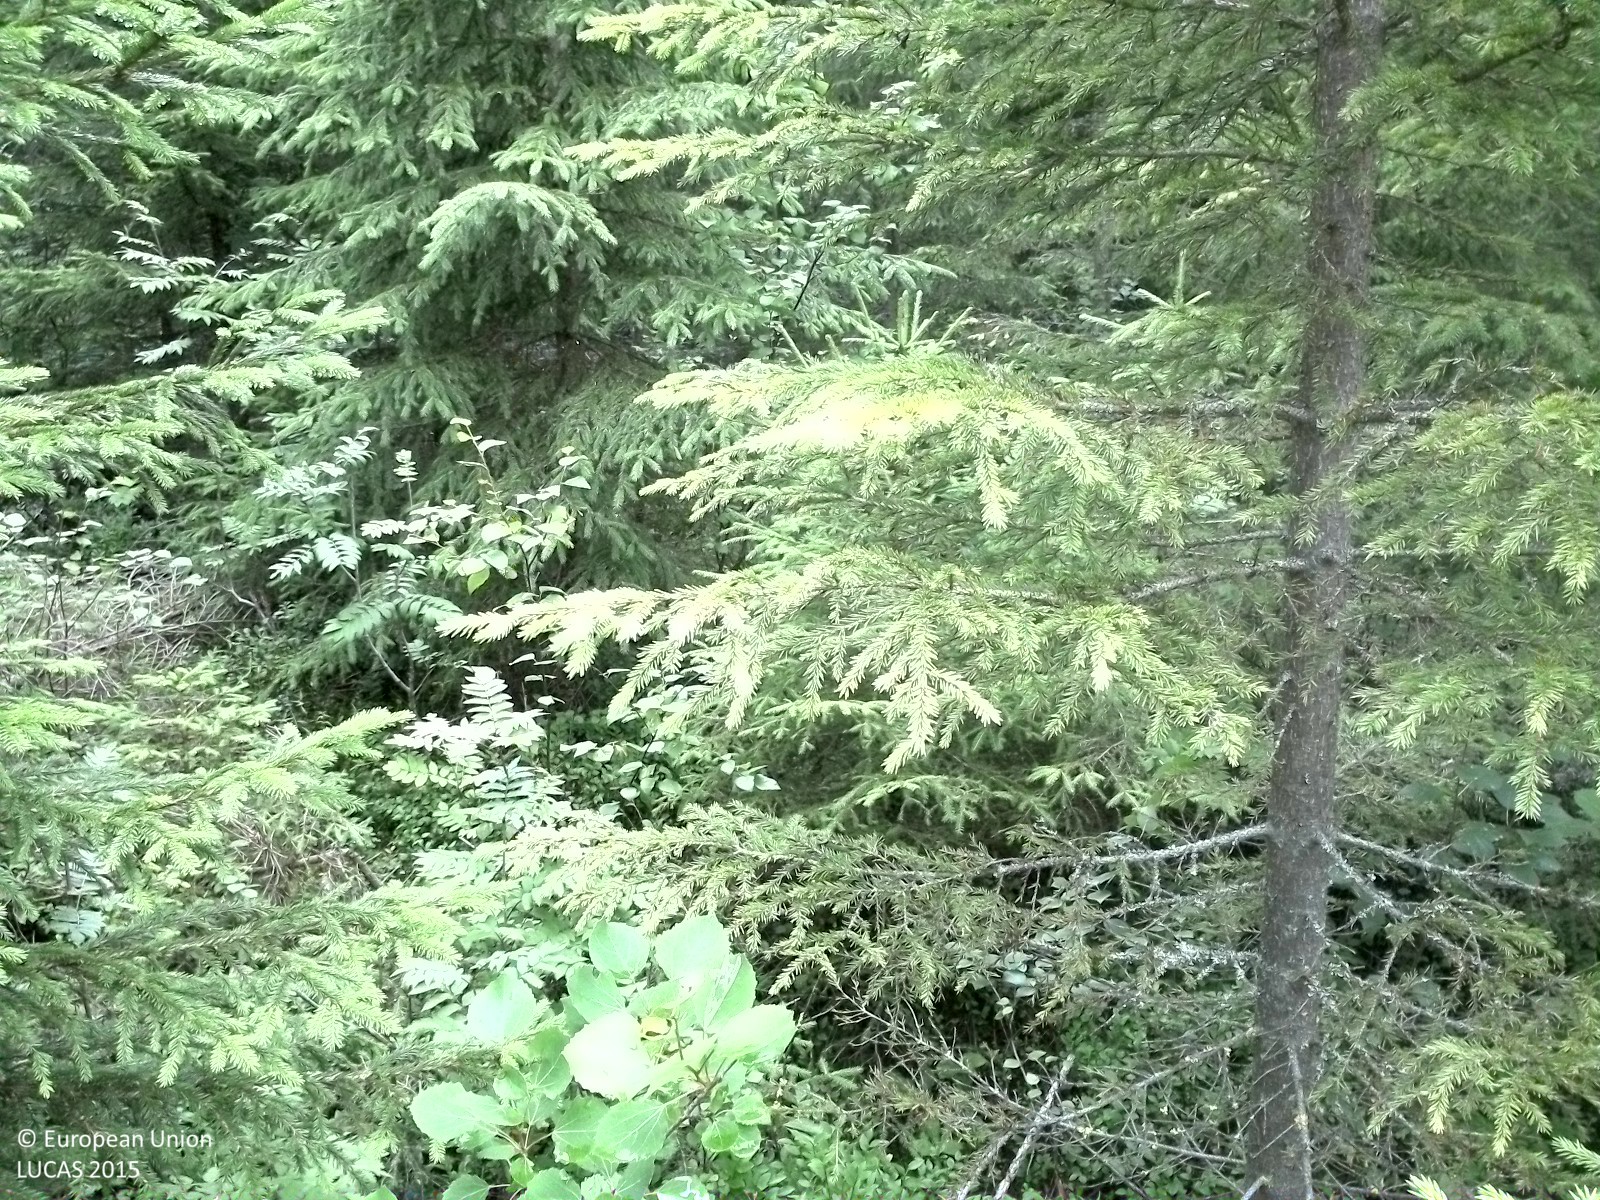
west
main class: Woodland
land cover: Spruce dominated coniferous woodland
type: boreal forest
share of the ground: 50 - 75 %
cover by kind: coniferous forest trees 60 %, shrubs 40 %
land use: Forestry
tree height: < 5 m
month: August
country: SE
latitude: 62.5564
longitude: 17.0393
